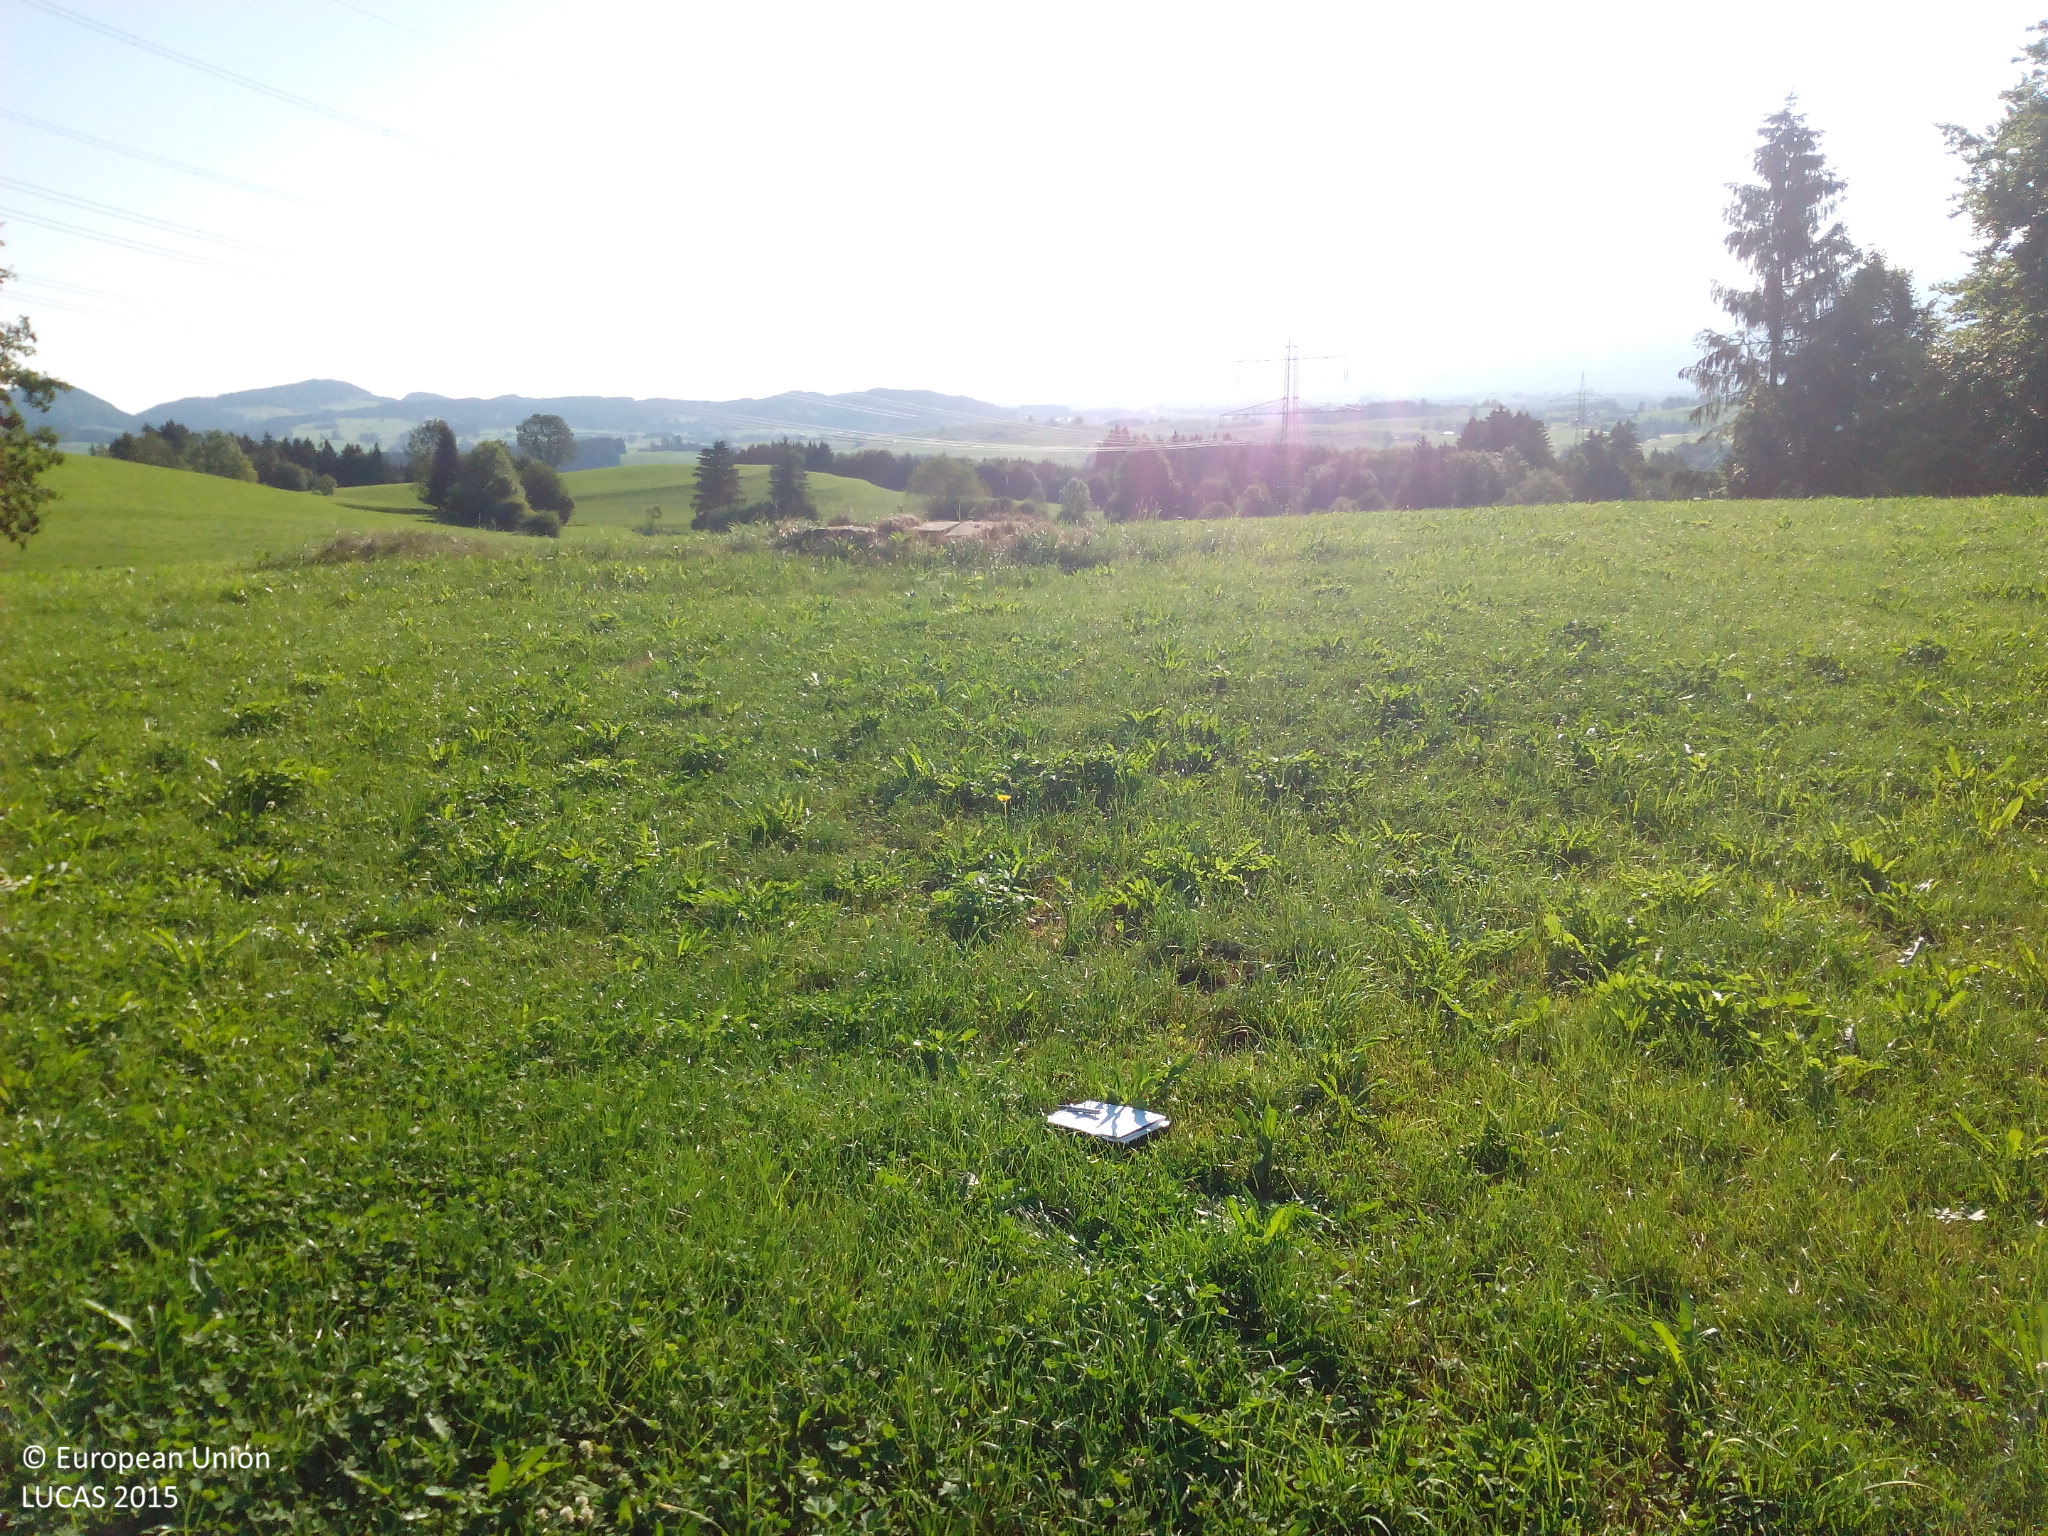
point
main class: Grassland
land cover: Grassland without tree/shrub cover
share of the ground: > 75 %
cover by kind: herbaceous plants 100 %
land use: Agriculture (excluding fallow land and kitchen gardens)
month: July
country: DE
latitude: 47.5920
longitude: 10.5979
